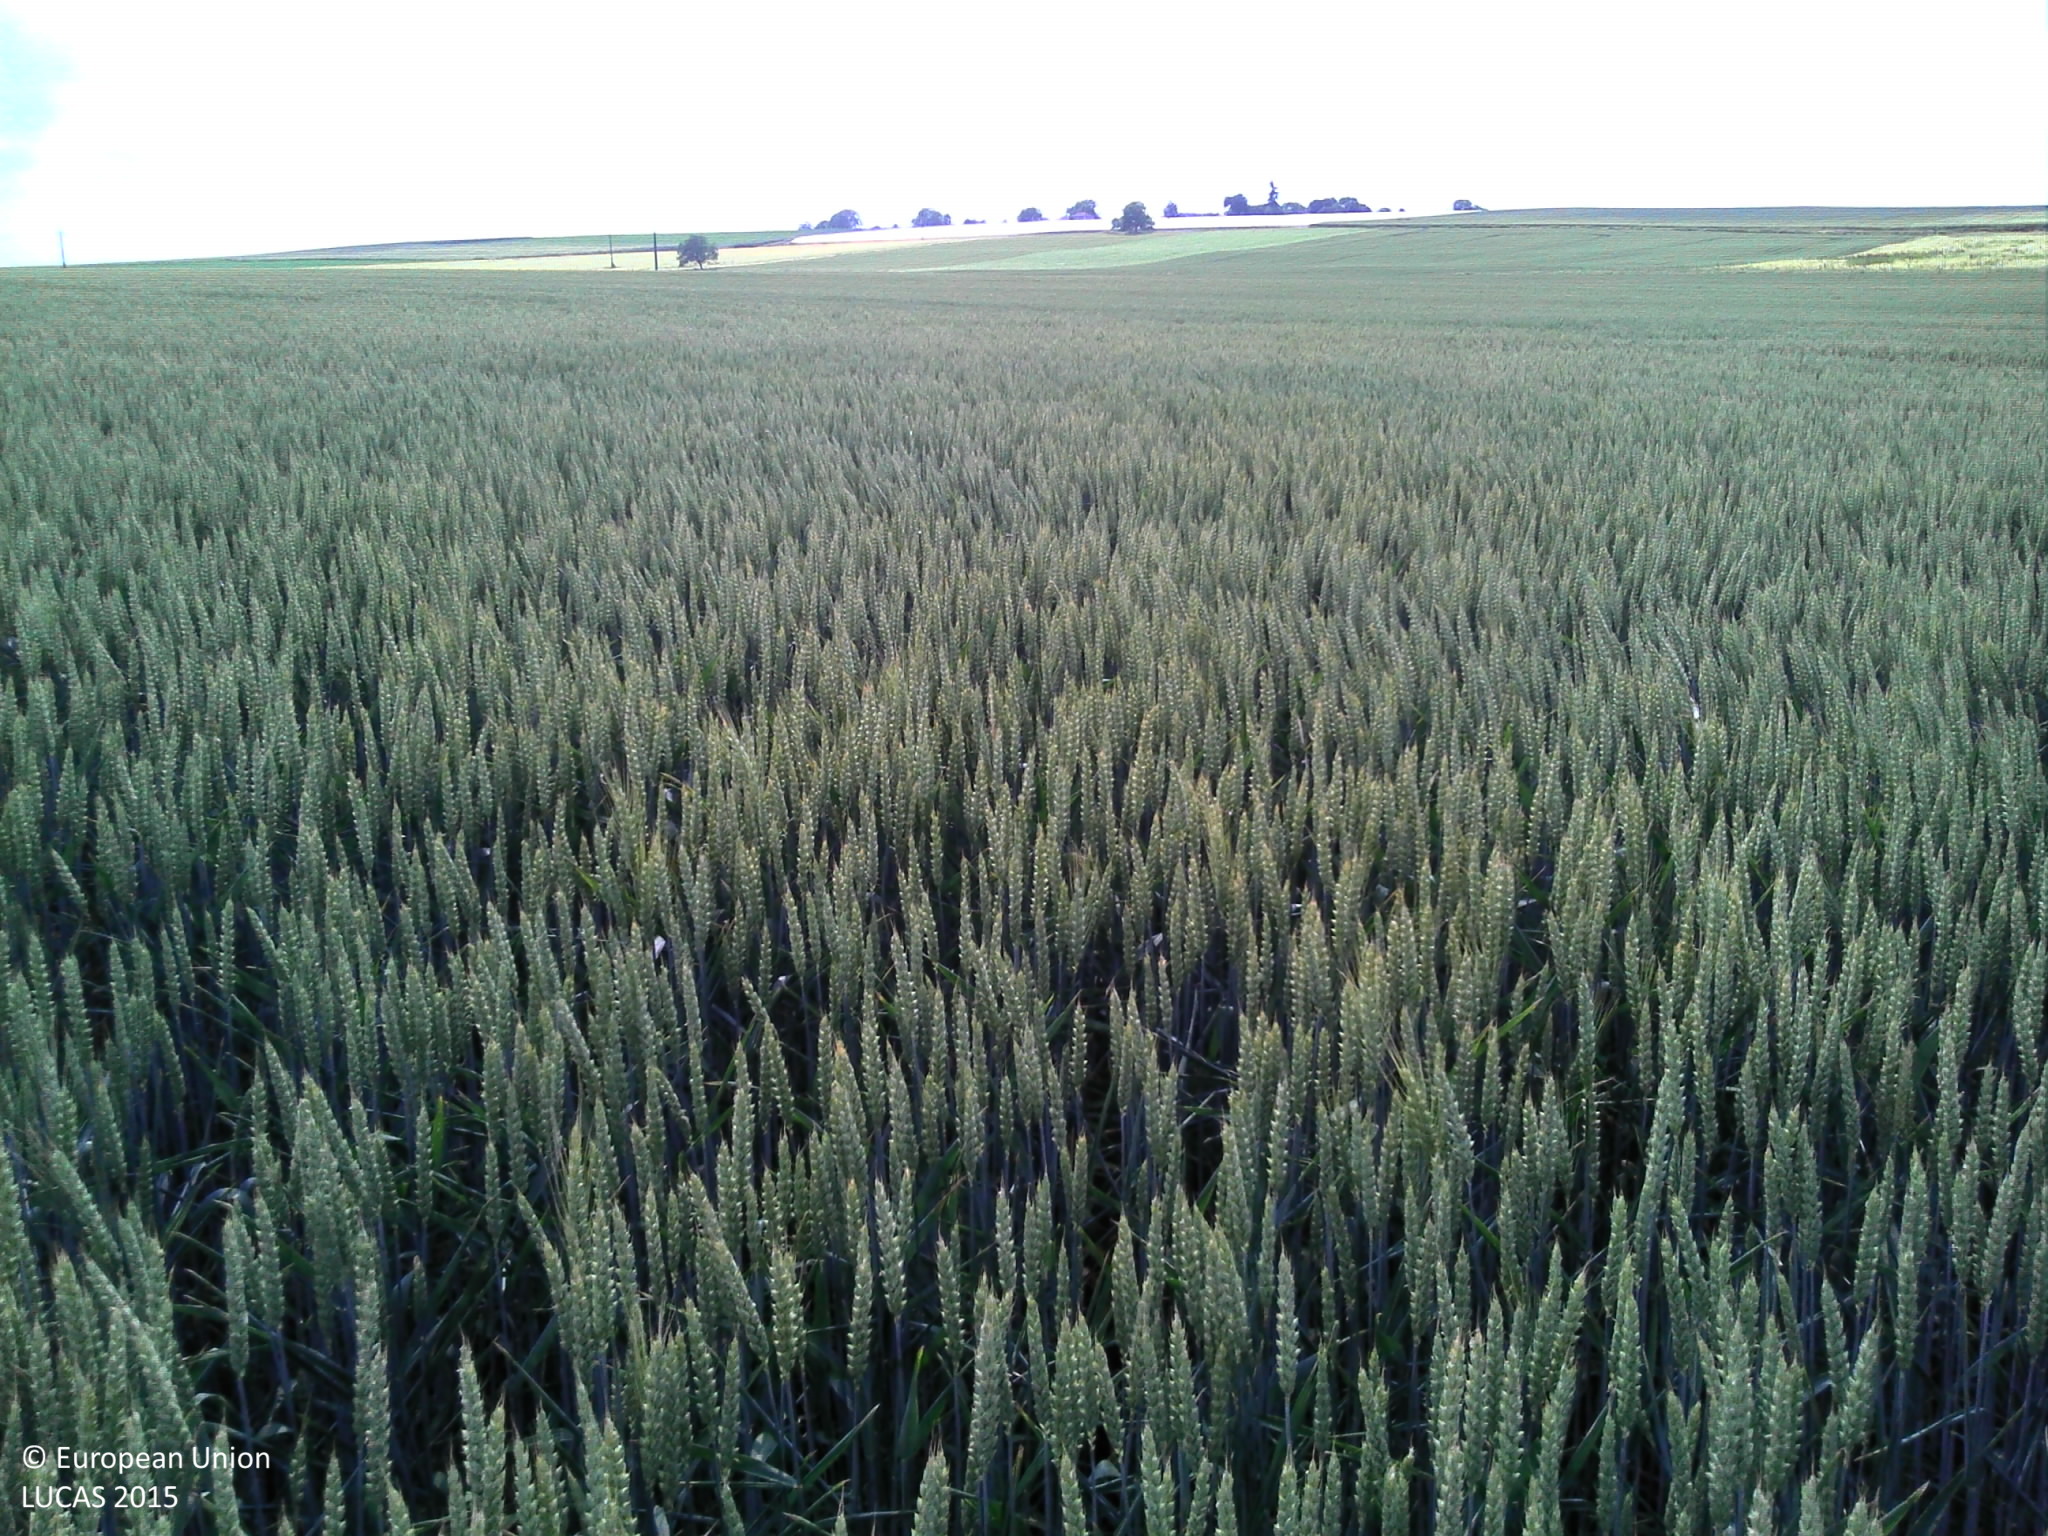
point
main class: Cropland
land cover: Common wheat
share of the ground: > 75 %
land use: Agriculture (excluding fallow land and kitchen gardens)
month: June
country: FR
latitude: 46.8441
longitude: 0.2094
